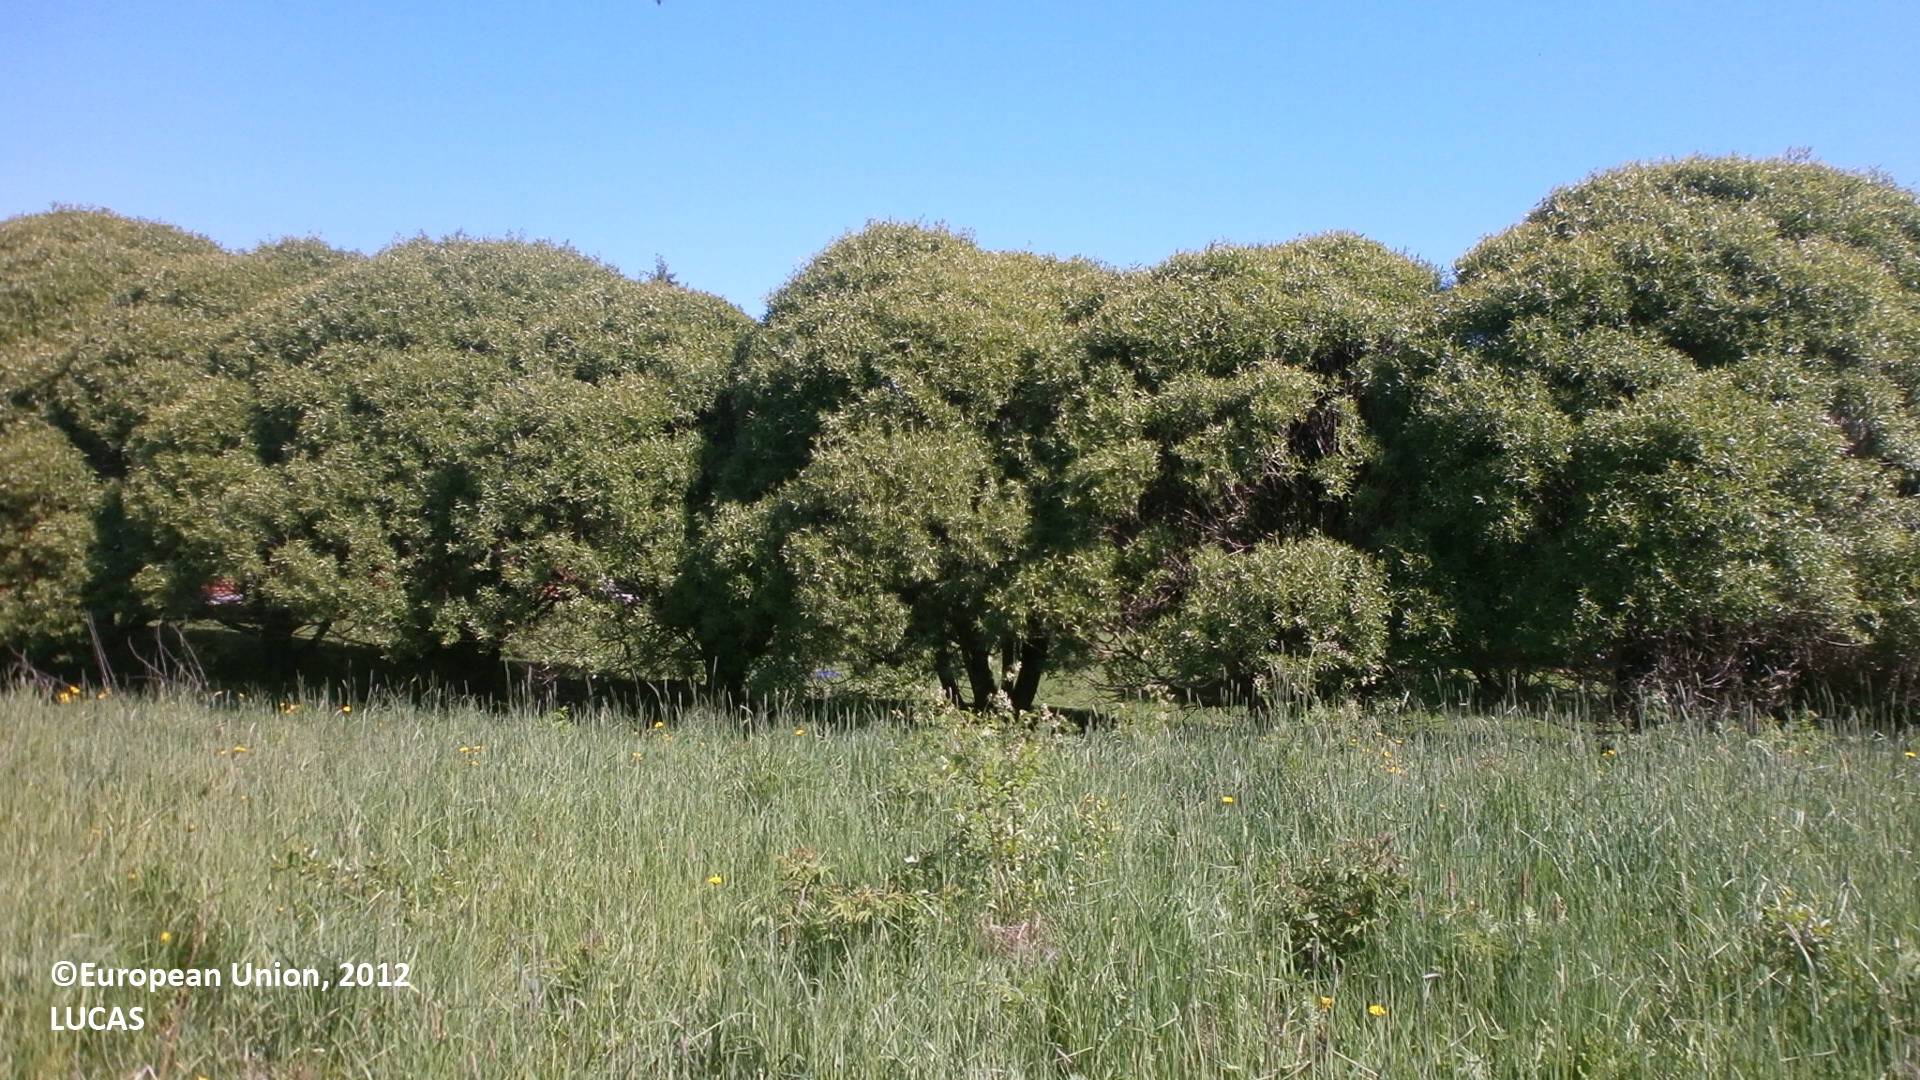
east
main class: Grassland
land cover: Grassland without tree/shrub cover
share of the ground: > 75 %
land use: Agriculture (excluding fallow land and kitchen gardens)
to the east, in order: Grassland without tree/shrub cover; Ditches and canals; Abandoned hedges; Artificial constructions in urban areas; Ditches and canals; Grassland without tree/shrub cover; Broadleaved woodland; Ditches and canals; Other mixed woodland; Electric lines; Ditches and canals; Other mixed woodland; Ditches and canals; Grassland with sparse tree/shrub cover; Paved roads, cycling and walking lanes; Grassland with sparse tree/shrub cover; Ditches and canals; Grass margins; Oats
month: June
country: FI
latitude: 63.9803
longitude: 25.6897
